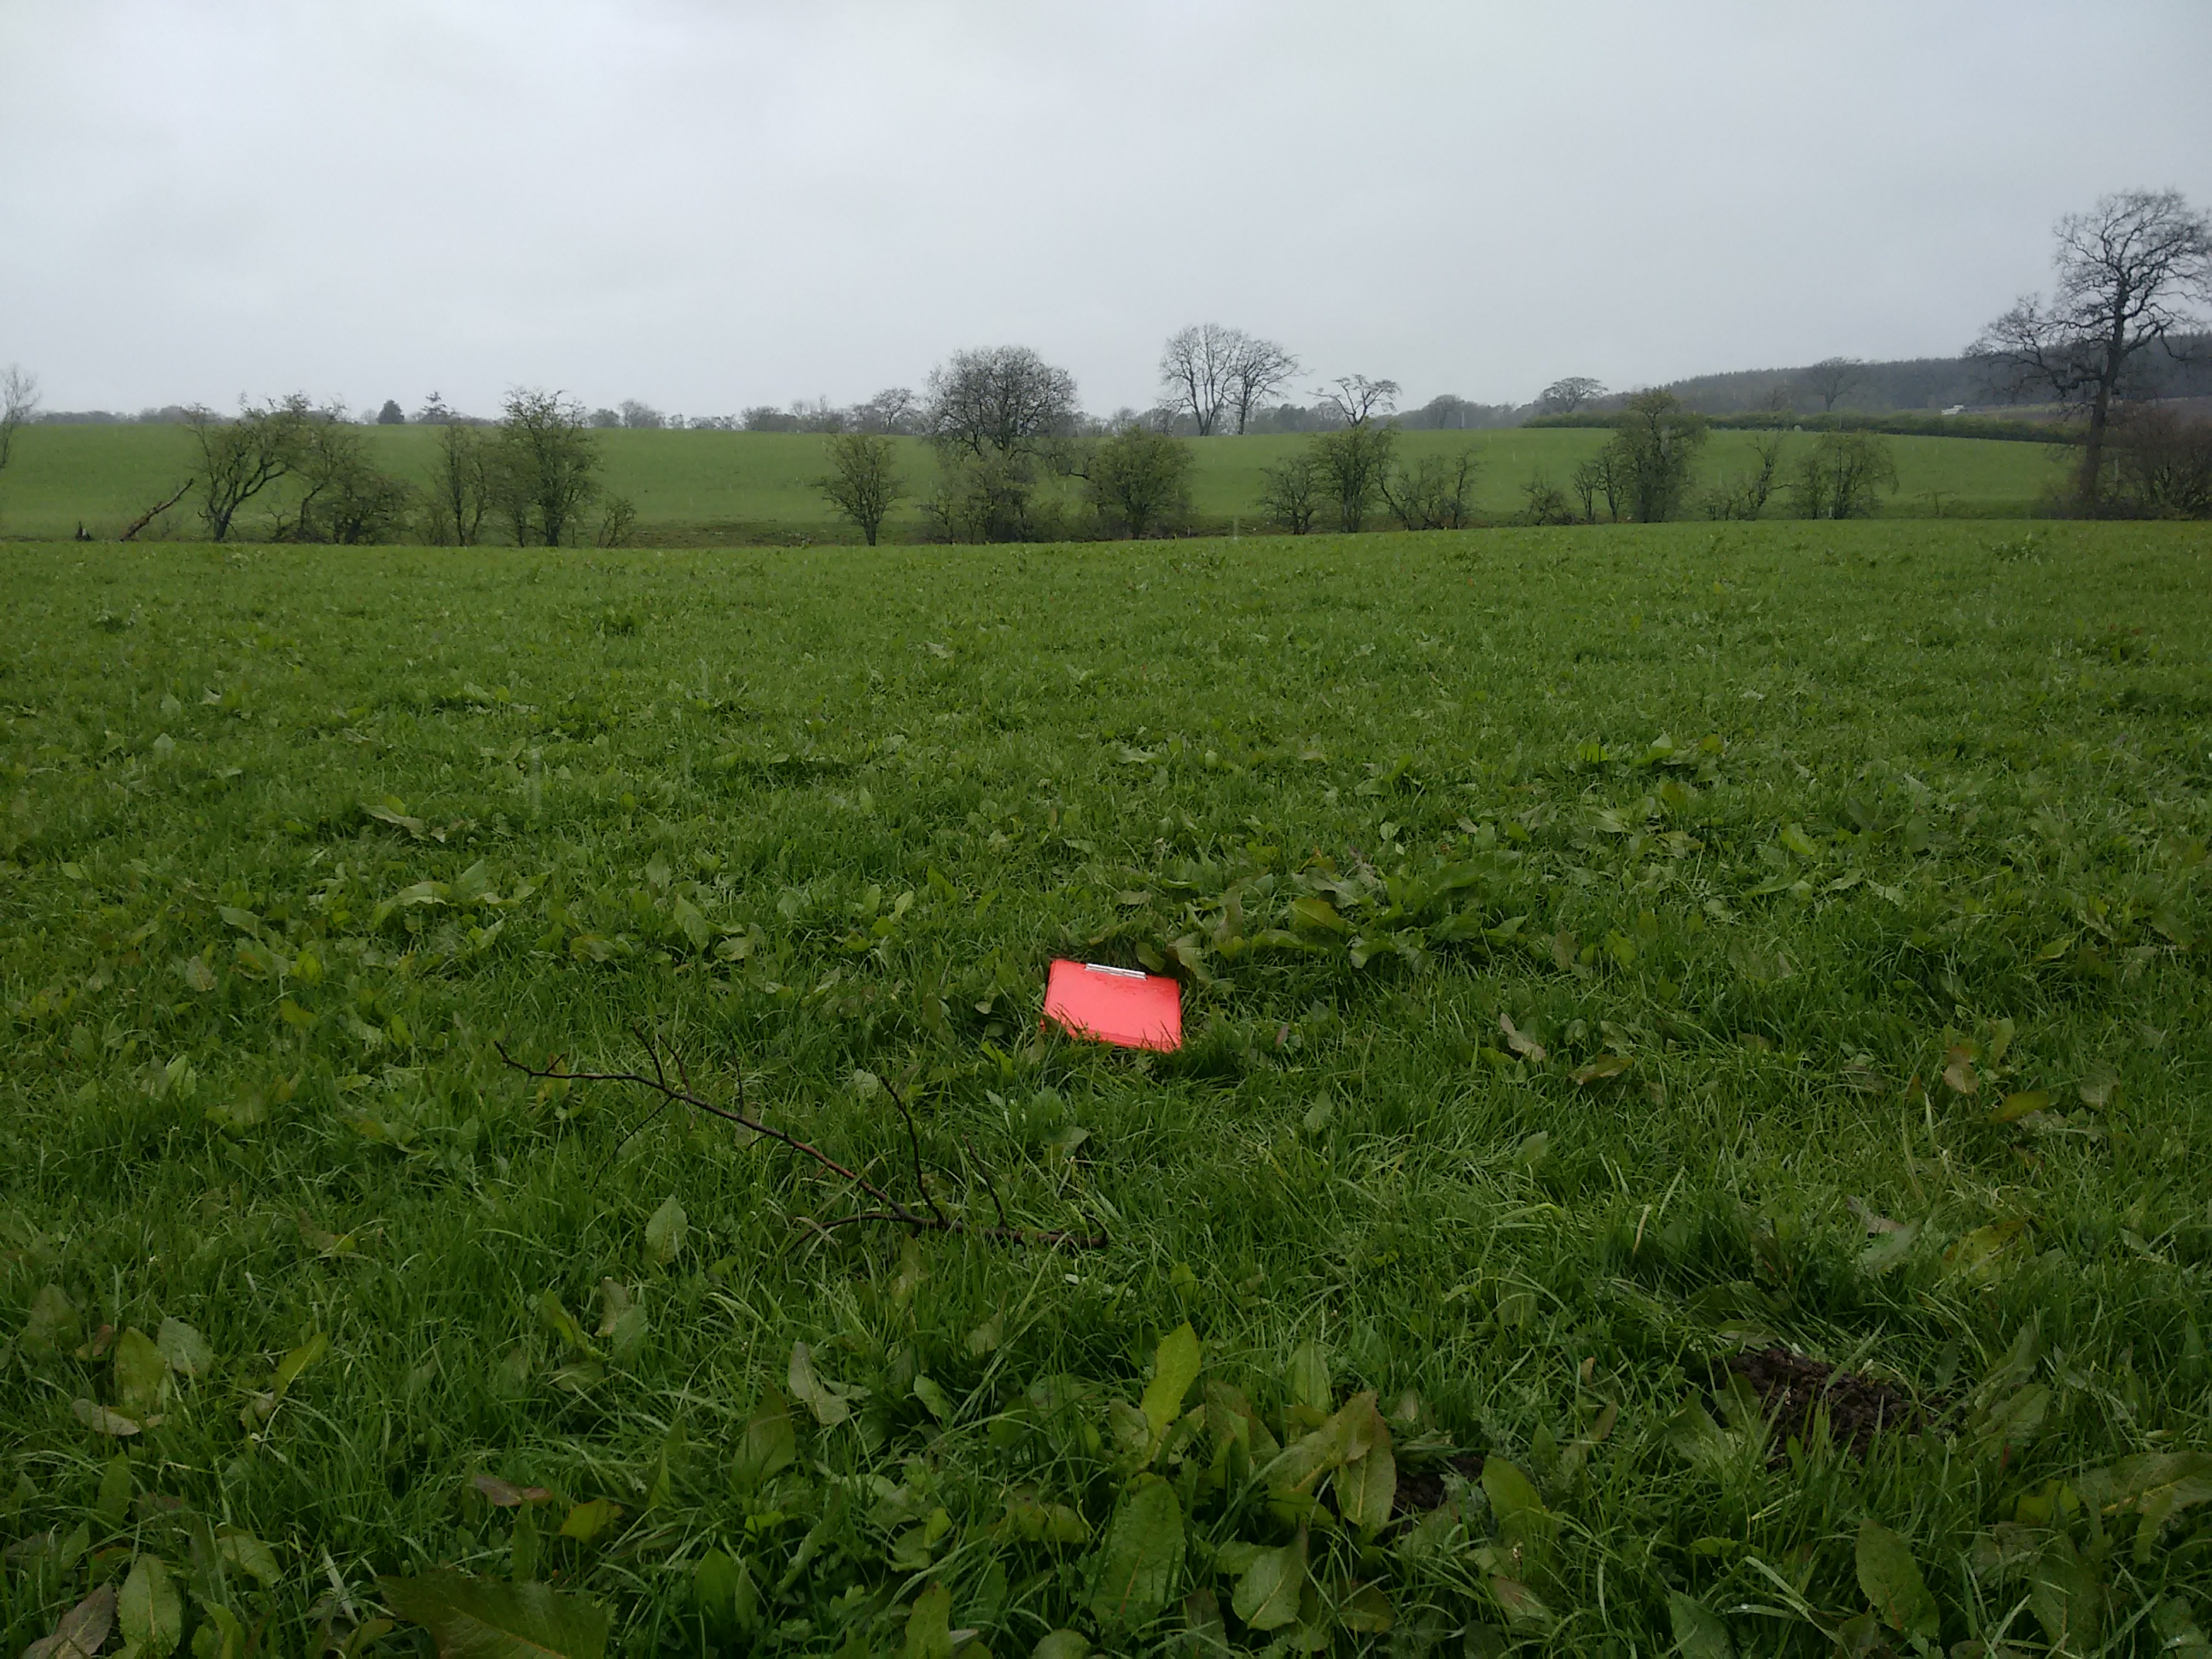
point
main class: Grassland
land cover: Grassland without tree/shrub cover
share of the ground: > 75 %
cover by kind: herbaceous plants 100 %
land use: Agriculture (excluding fallow land and kitchen gardens)
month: May
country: GB
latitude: 55.7971
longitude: -3.8508
